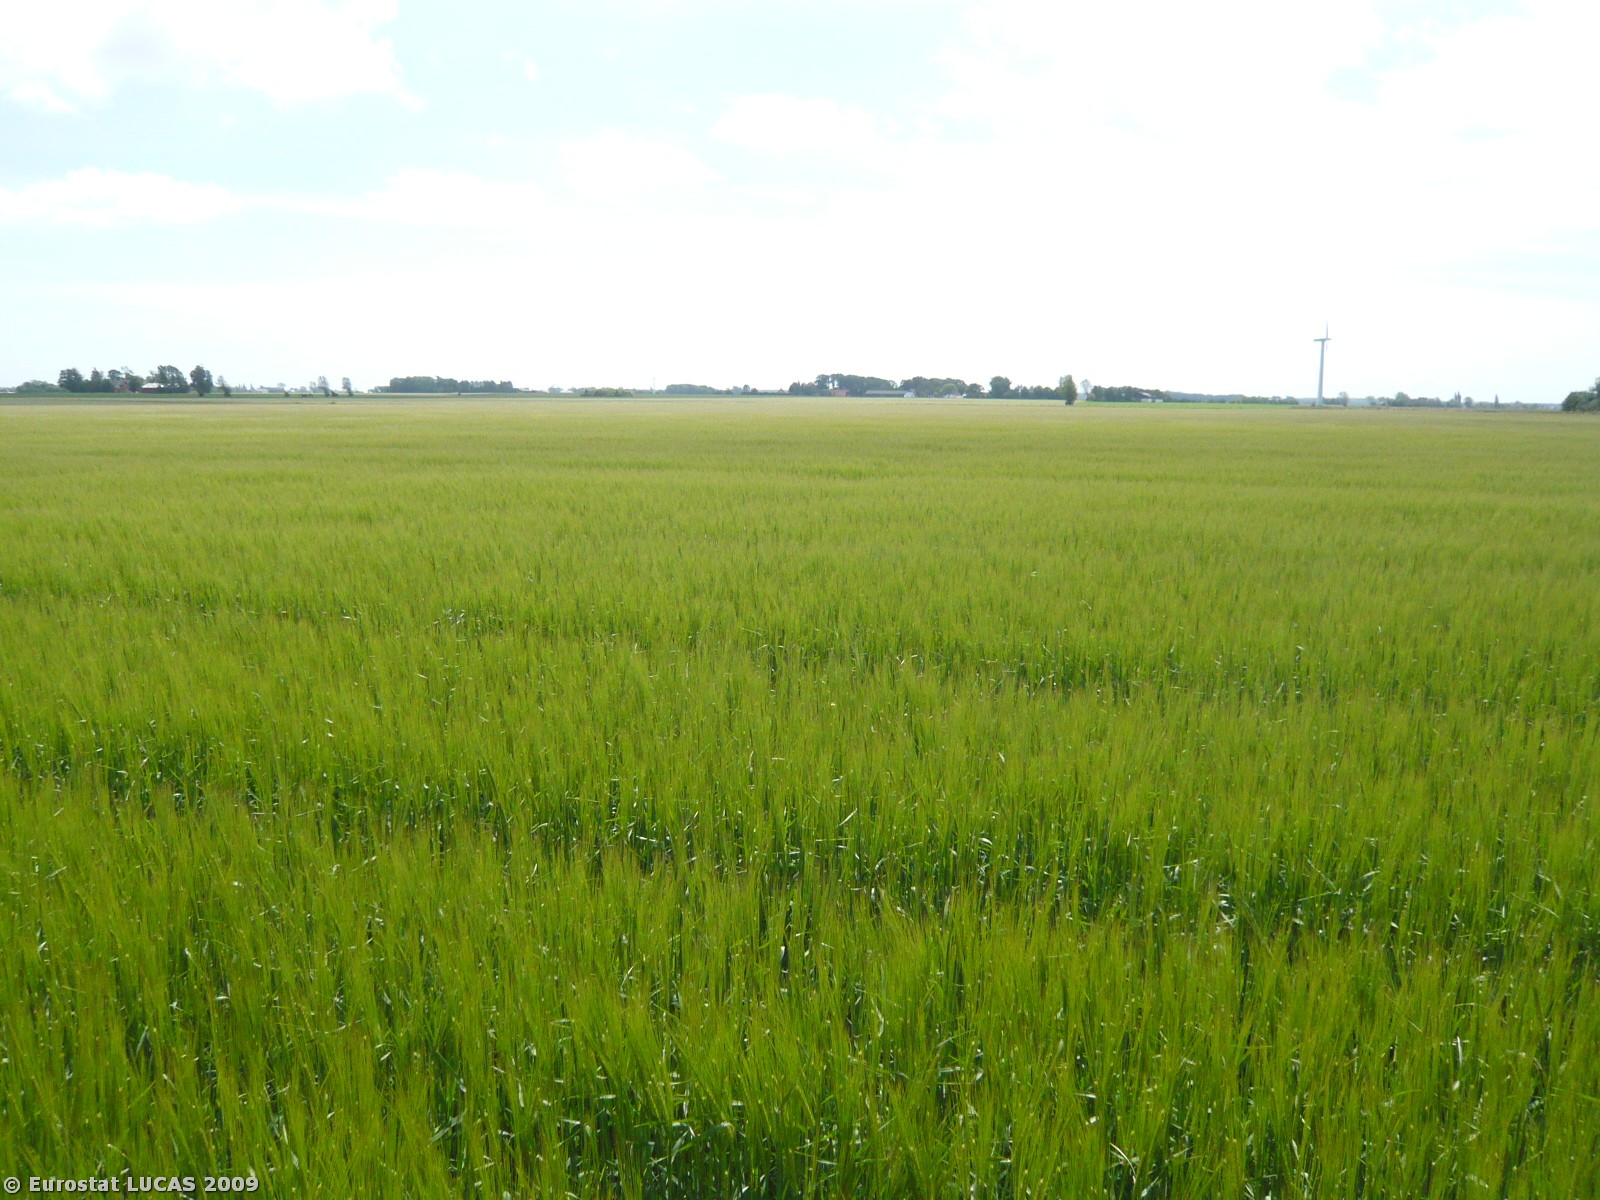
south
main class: Cropland
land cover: Barley
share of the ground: > 75 %
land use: Agriculture (excluding fallow land and kitchen gardens)
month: June
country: DK
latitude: 54.7986
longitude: 11.1347
